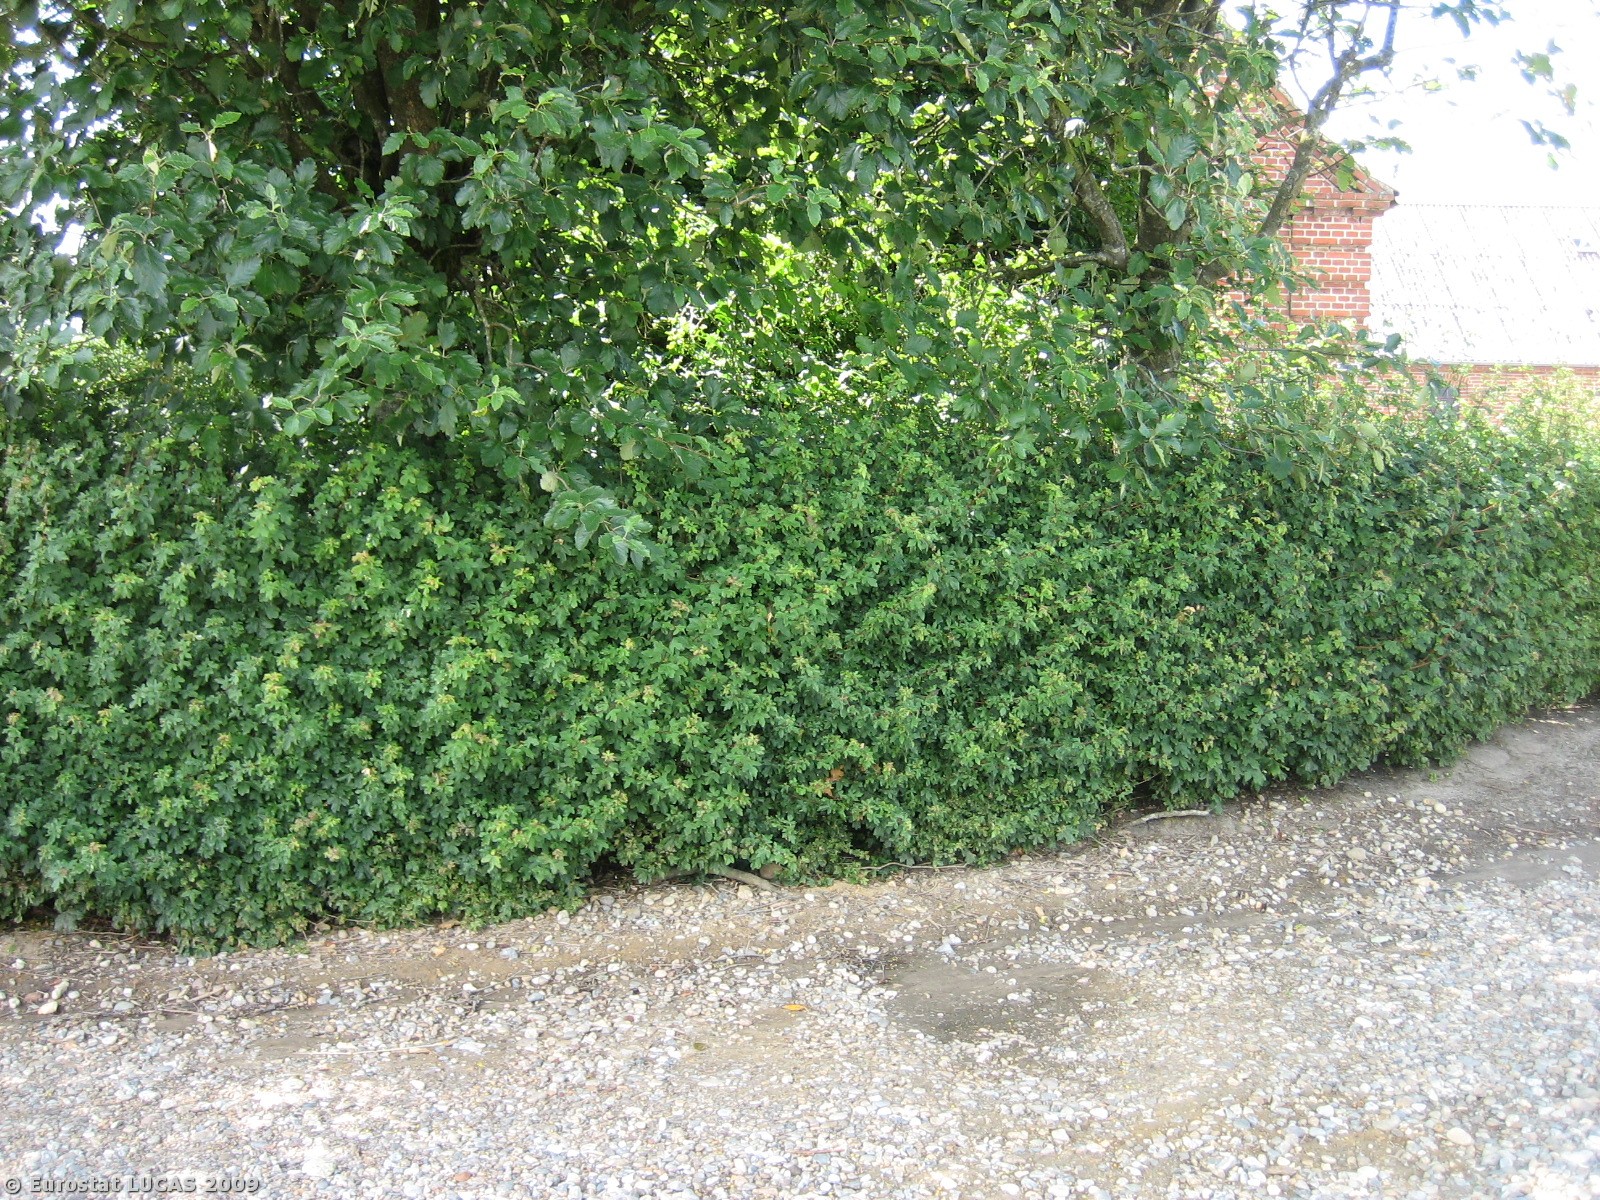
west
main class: Cropland
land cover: Common wheat
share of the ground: > 75 %
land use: Agriculture (excluding fallow land and kitchen gardens)
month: July
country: DK
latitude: 55.6070
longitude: 8.8106
